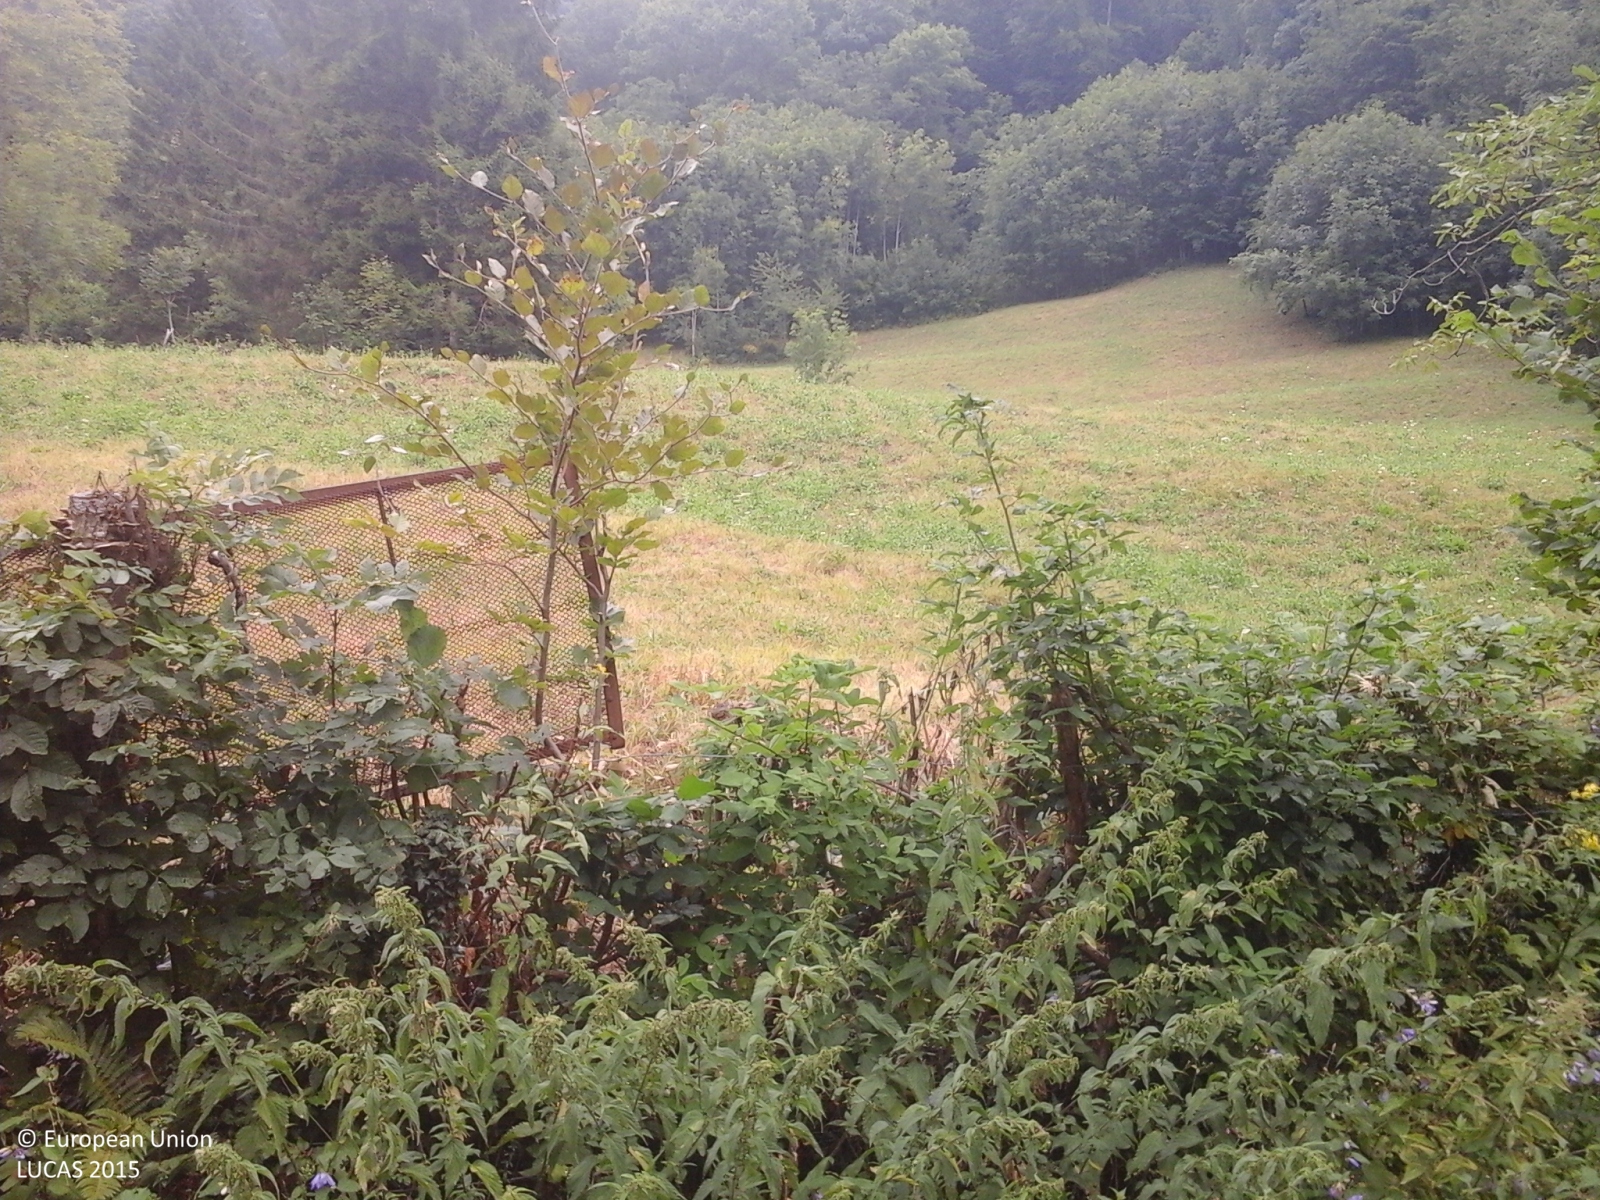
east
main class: Grassland
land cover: Grassland without tree/shrub cover
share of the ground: > 75 %
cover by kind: herbaceous plants 100 %
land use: Agriculture (excluding fallow land and kitchen gardens)
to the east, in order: Grassland without tree/shrub cover; Broadleaved woodland; Grassland without tree/shrub cover; Broadleaved woodland; Grassland without tree/shrub cover; Broadleaved woodland
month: July
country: IT
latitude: 45.9158
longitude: 9.1890
